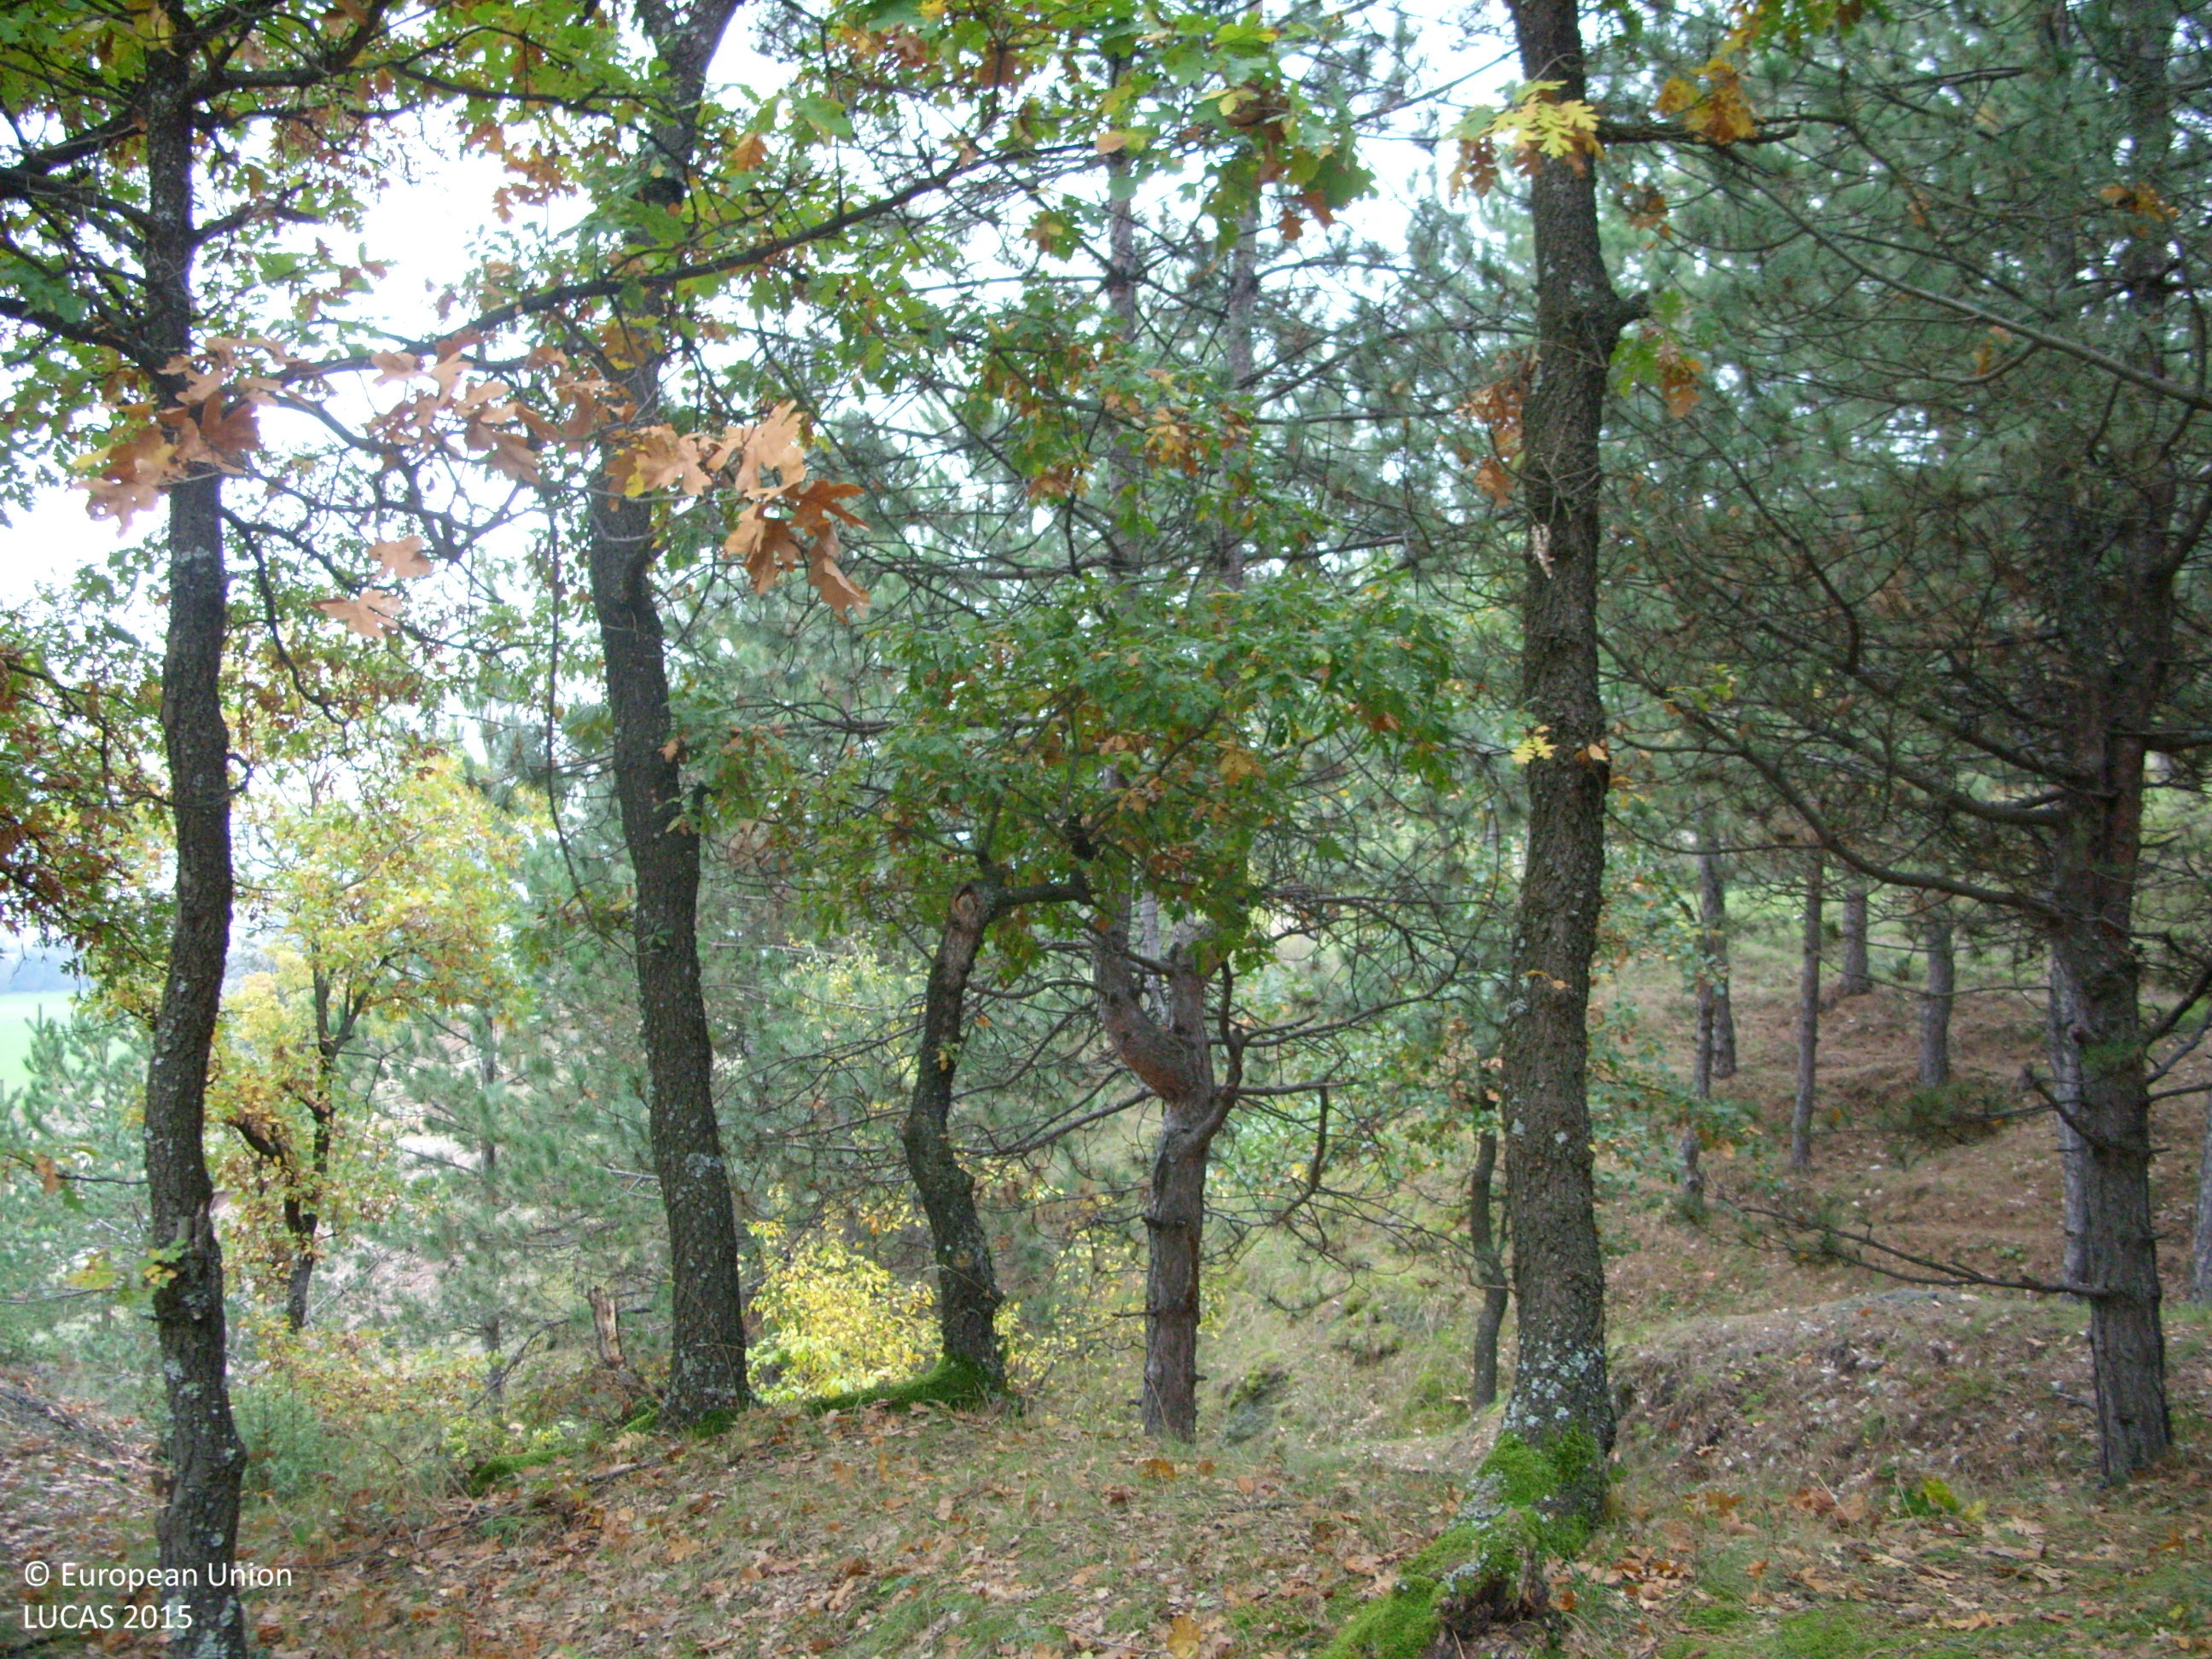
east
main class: Woodland
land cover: Pine dominated mixed woodland
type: hemiboreal forest and nemoral coniferous forest and mixed broadleaved-coniferous forest
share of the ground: > 75 %
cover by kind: coniferous forest trees 40 %, broadleaved forest trees 40 %, herbaceous plants 20 %
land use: Forestry
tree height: > 5 m
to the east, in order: Pine dominated mixed woodland; Rocks and stones; Grassland with sparse tree/shrub cover; Artificial constructions; Grass margins; Tracks; Other bare soil; Grassland with sparse tree/shrub cover; Other bare soil; Grassland without tree/shrub cover
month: October
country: BG
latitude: 42.4939
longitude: 24.1717
